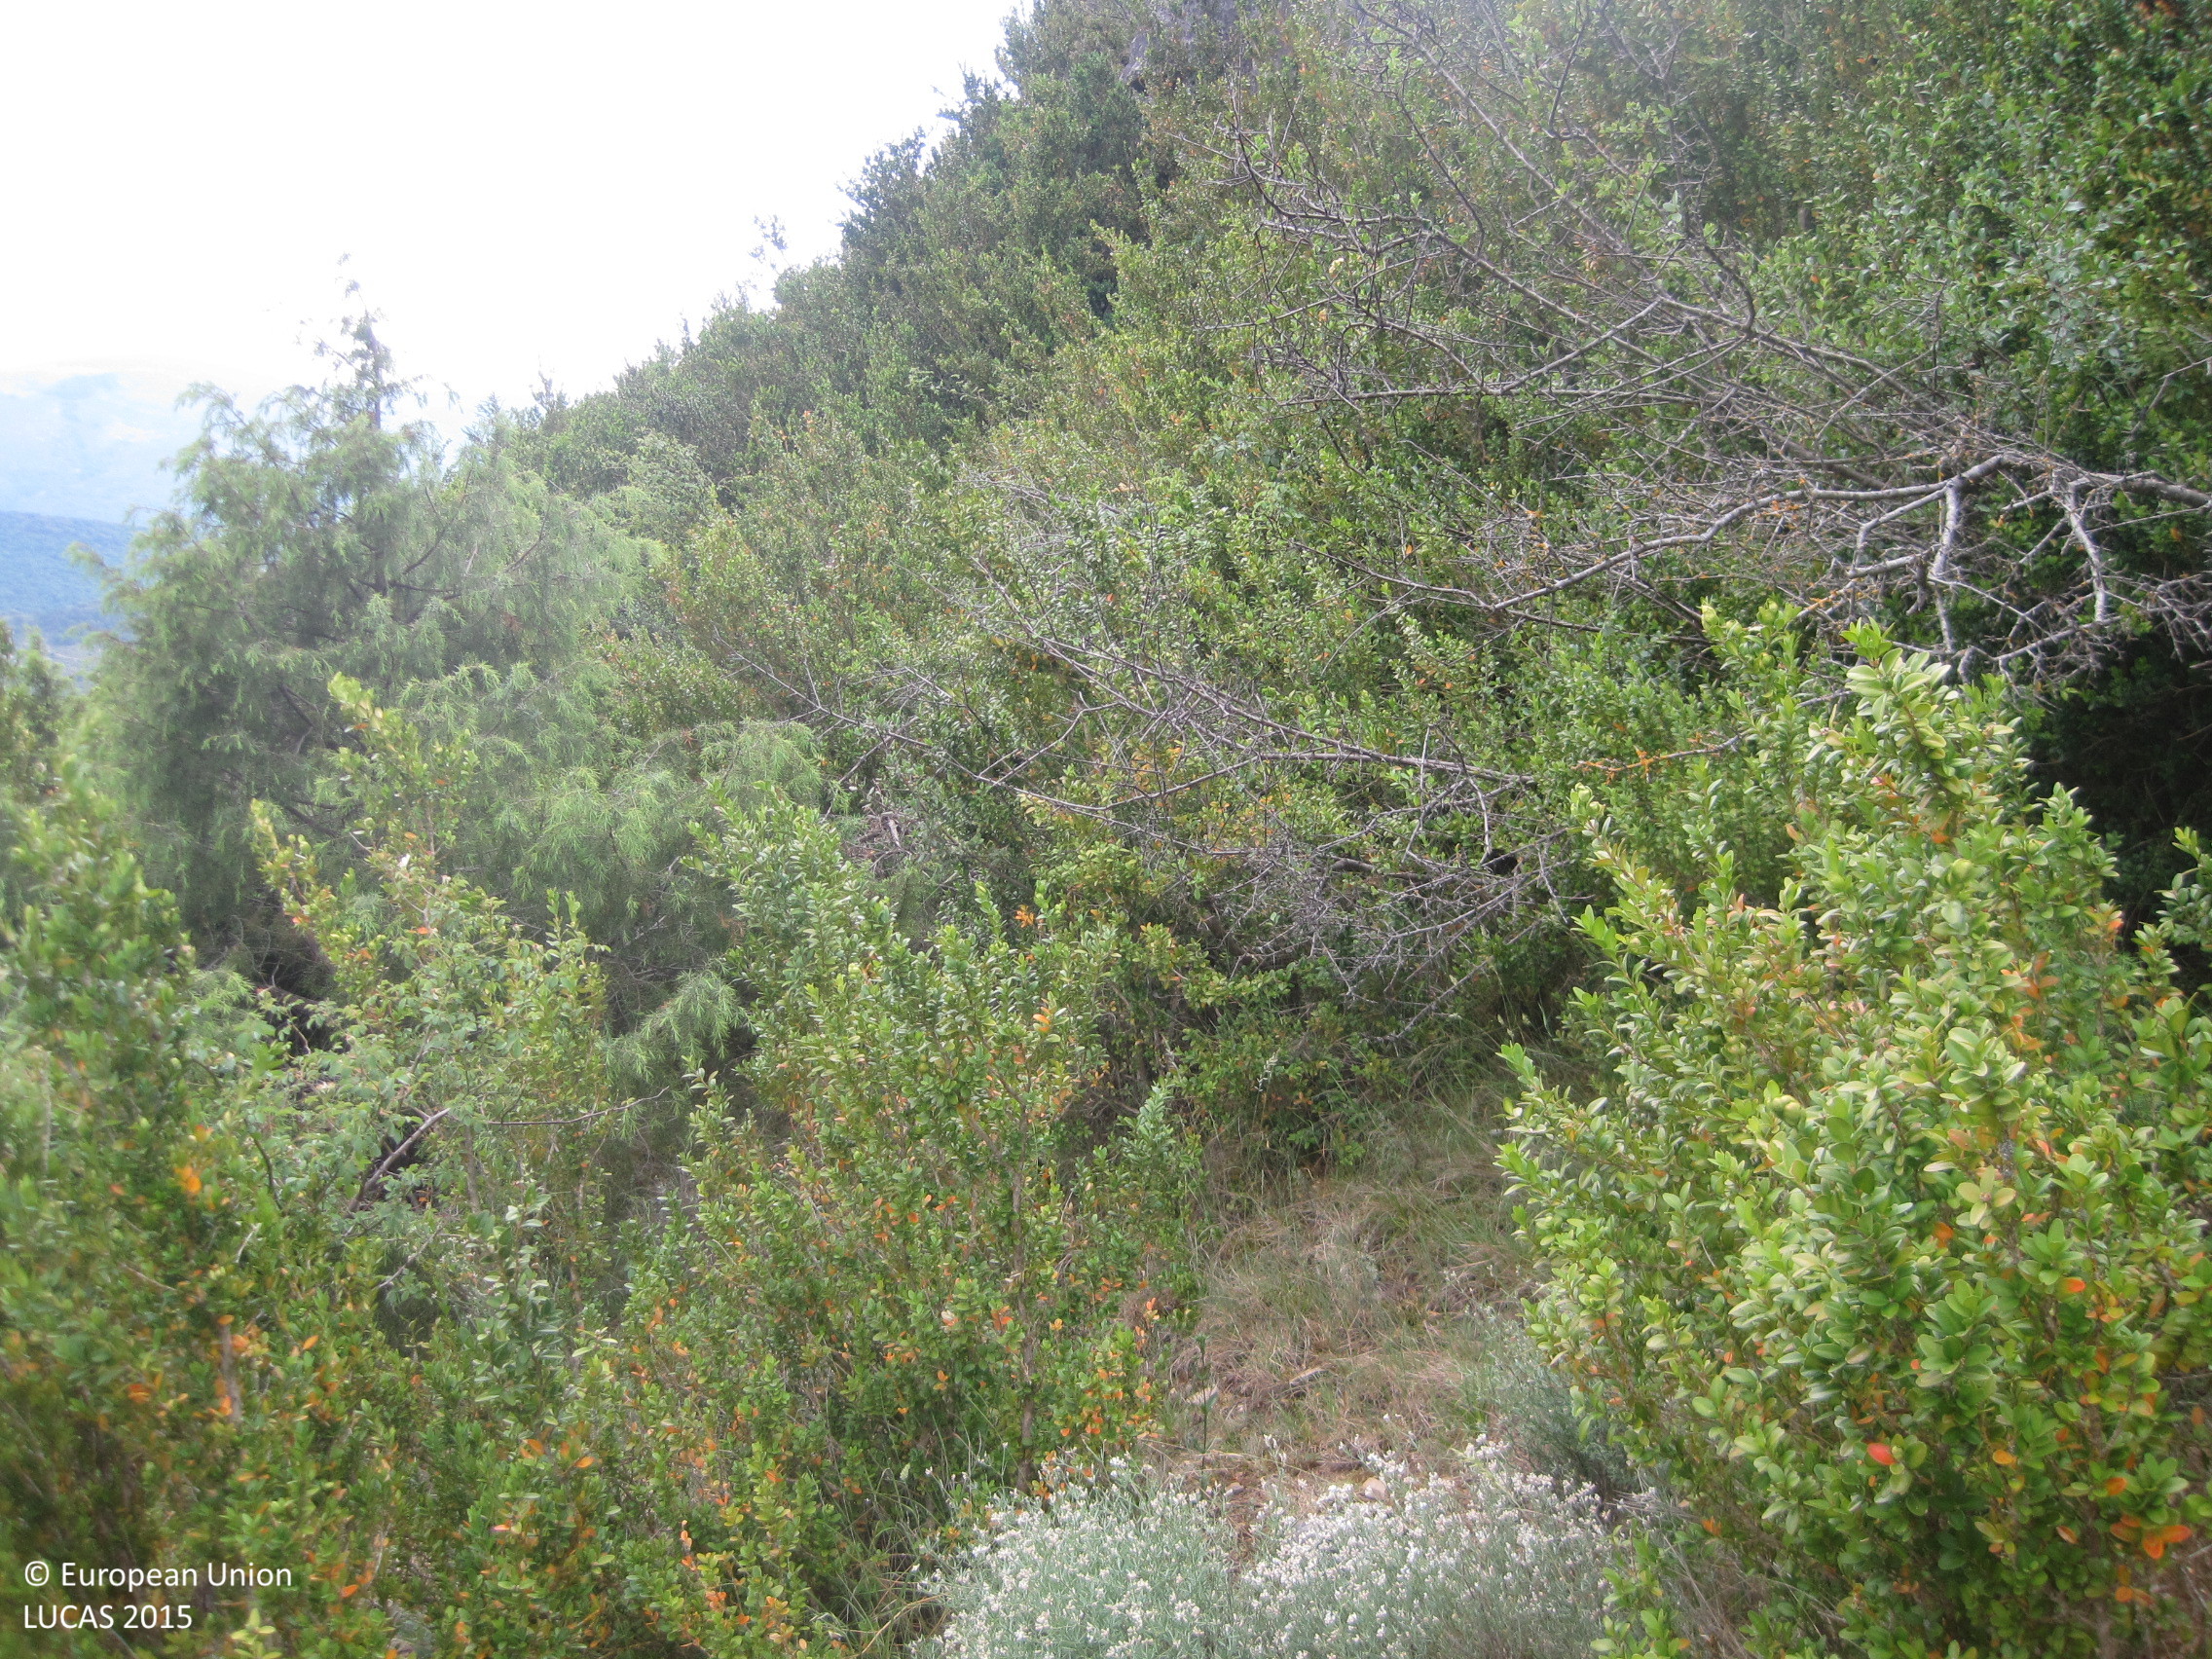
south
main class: Shrubland
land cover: Shrubland without tree cover
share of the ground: > 75 %
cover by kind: shrubs 50 %, herbaceous plants 30 %, unconsolidated bare surface 20 %
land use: Agriculture (excluding fallow land and kitchen gardens)
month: June
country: ES
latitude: 42.7015
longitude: -1.2286
